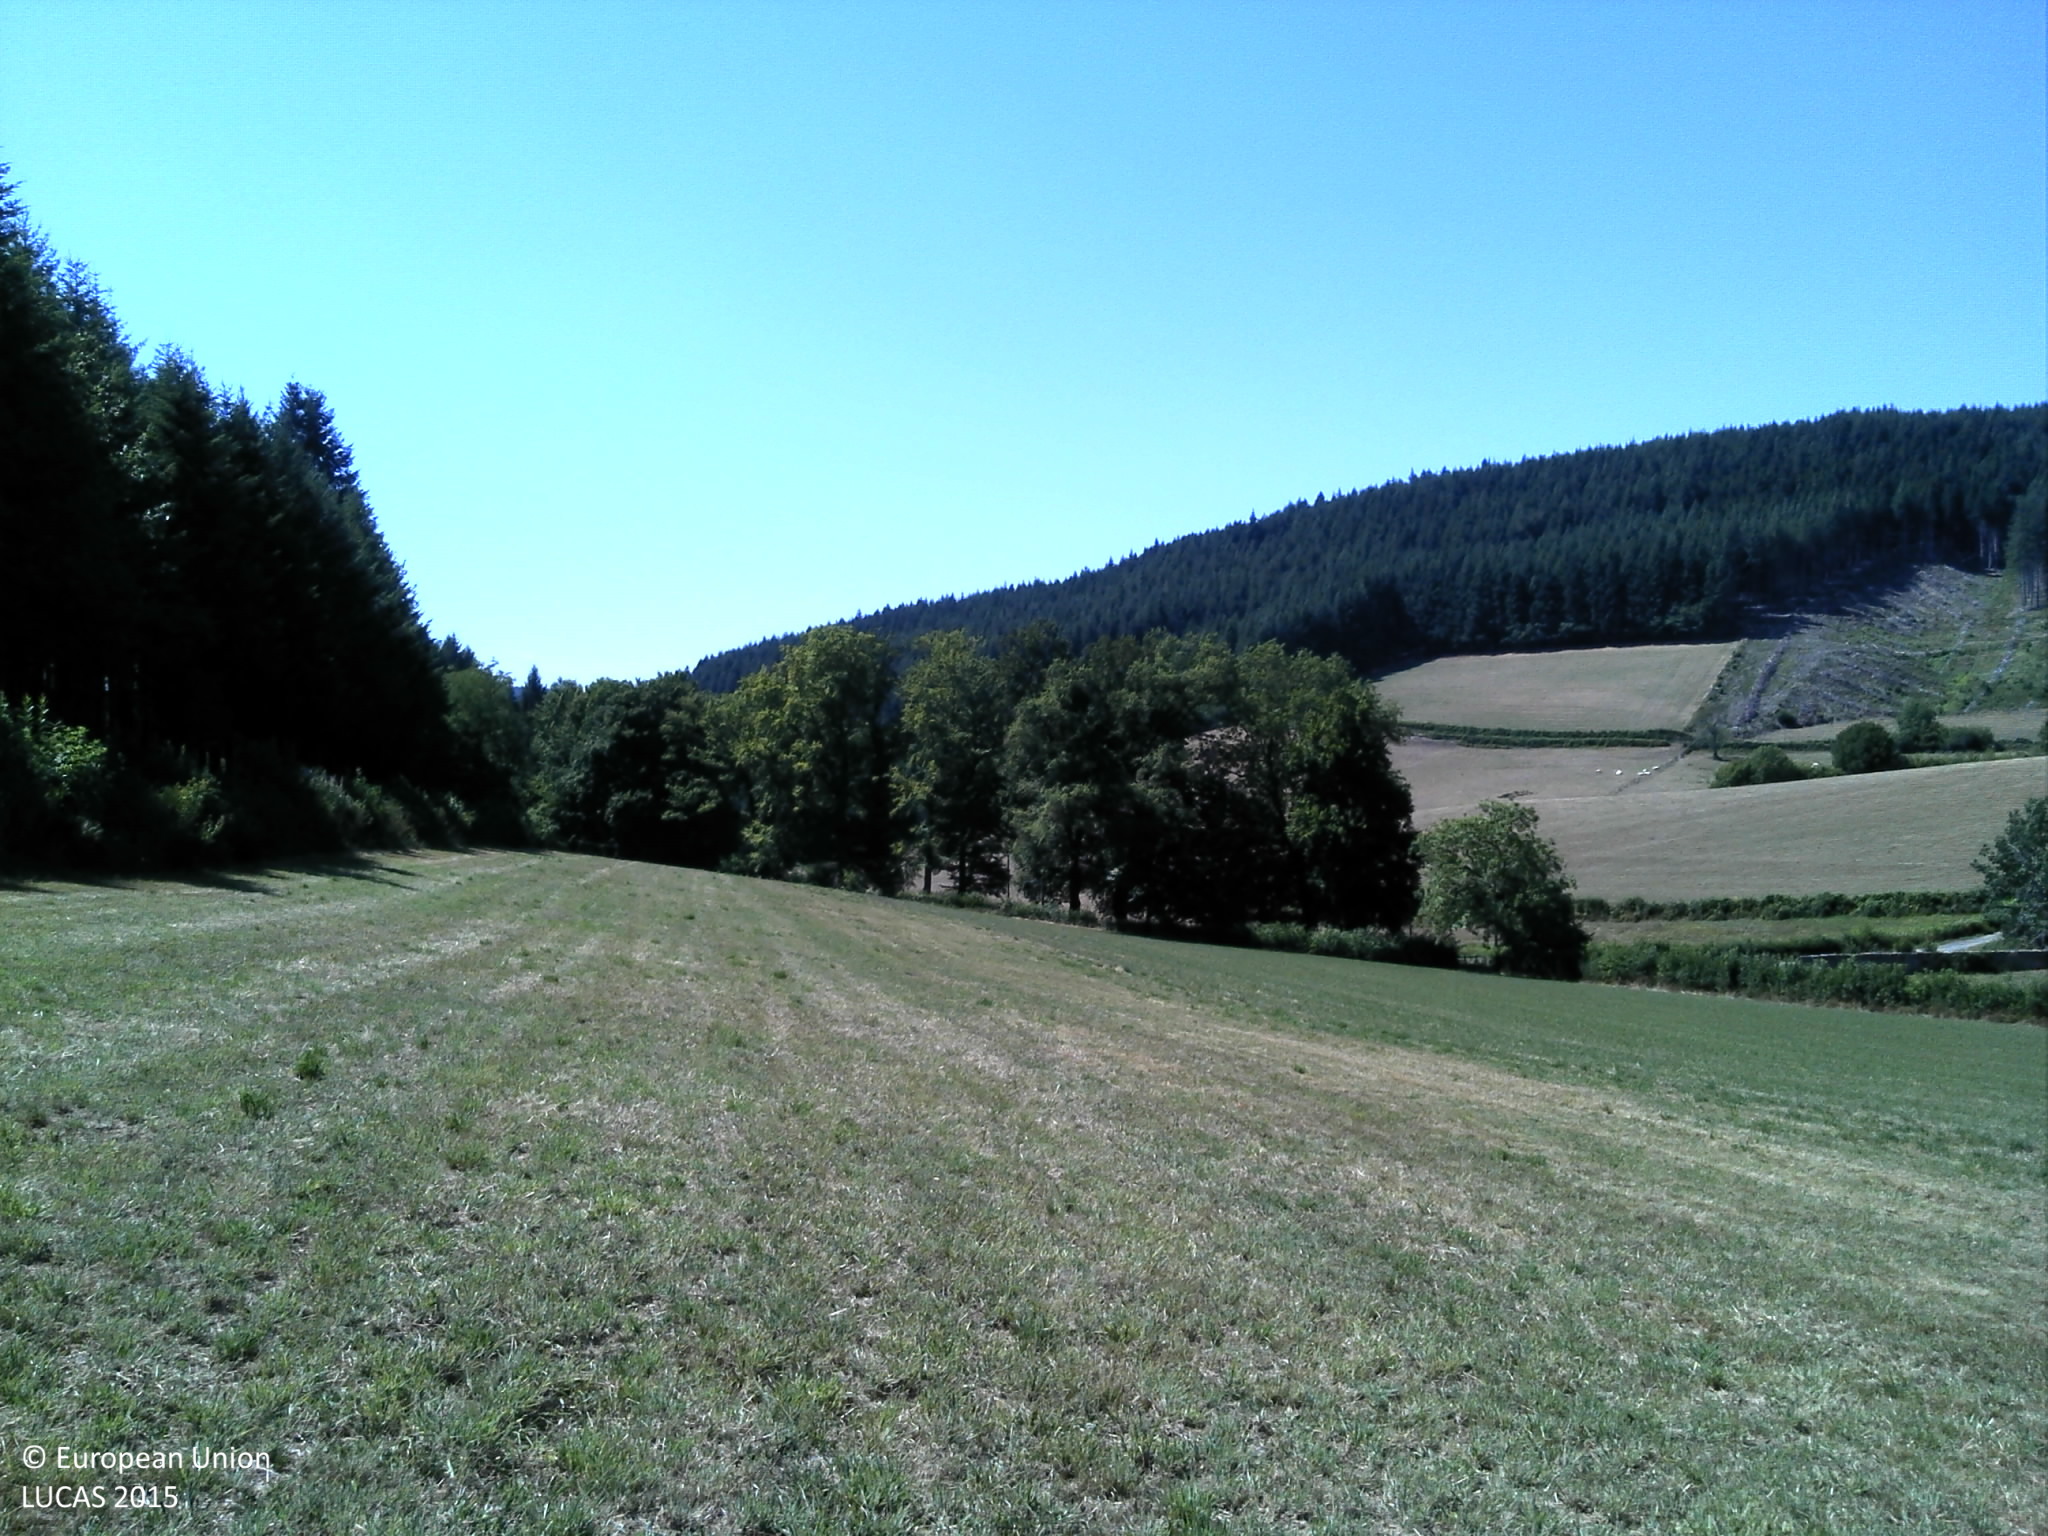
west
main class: Grassland
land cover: Grassland without tree/shrub cover
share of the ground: > 75 %
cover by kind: herbaceous plants 100 %
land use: Agriculture (excluding fallow land and kitchen gardens)
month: August
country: FR
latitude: 46.2054
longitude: 4.4159
